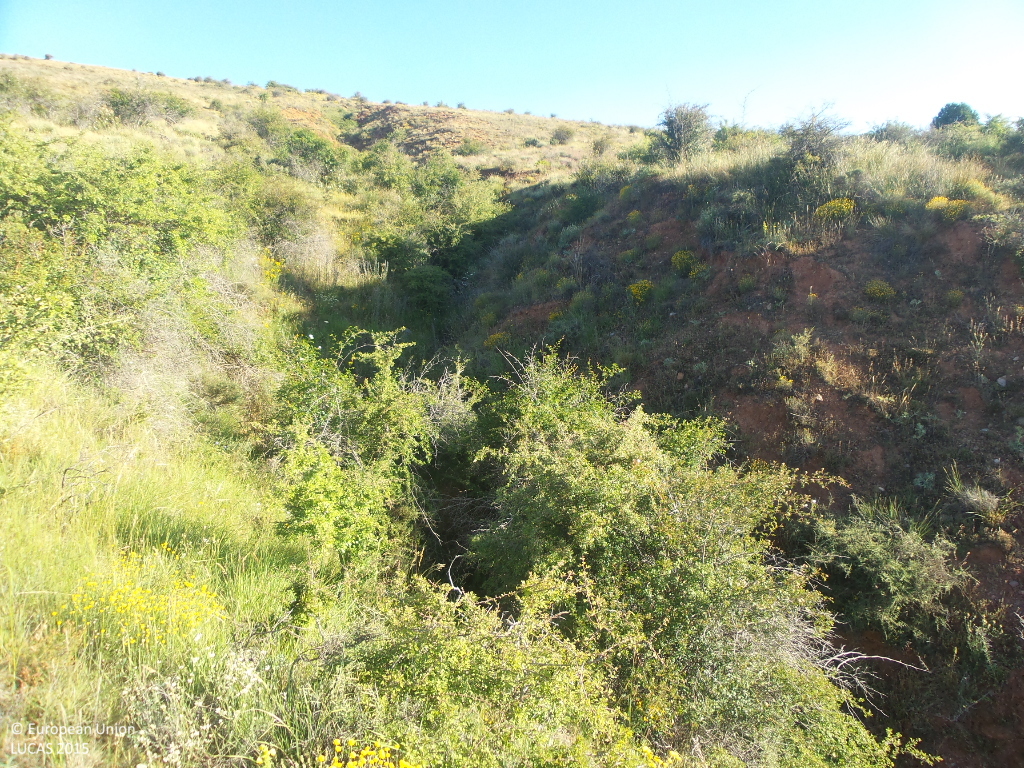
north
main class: Shrubland
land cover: Shrubland without tree cover
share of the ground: > 75 %
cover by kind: shrubs 80 %, herbaceous plants 10 %, unconsolidated bare surface 10 %
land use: Semi-natural and natural areas not in use
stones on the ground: < 10 %
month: June
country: ES
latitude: 41.2182
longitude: -2.9315
